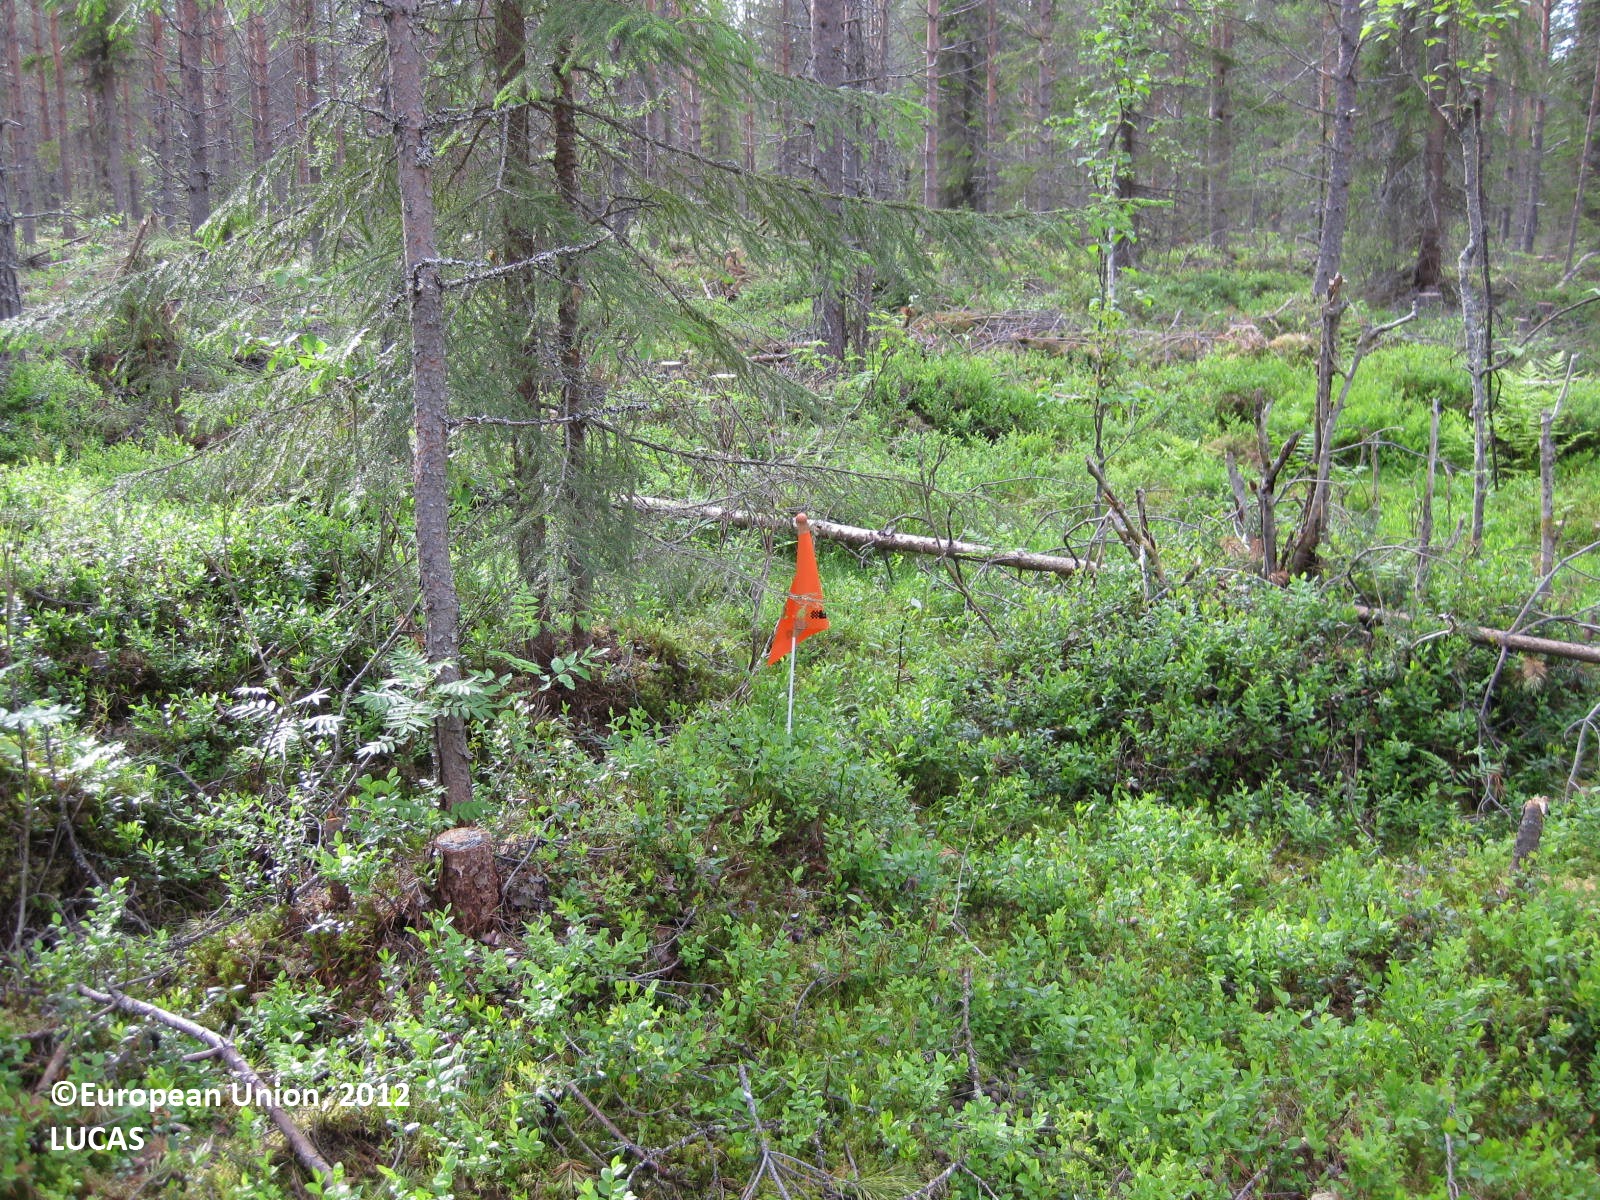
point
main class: Woodland
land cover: Pine dominated coniferous woodland
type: boreal forest
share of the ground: > 75 %
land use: Forestry
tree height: > 5 m
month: June
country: FI
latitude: 65.2750
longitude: 28.1741
